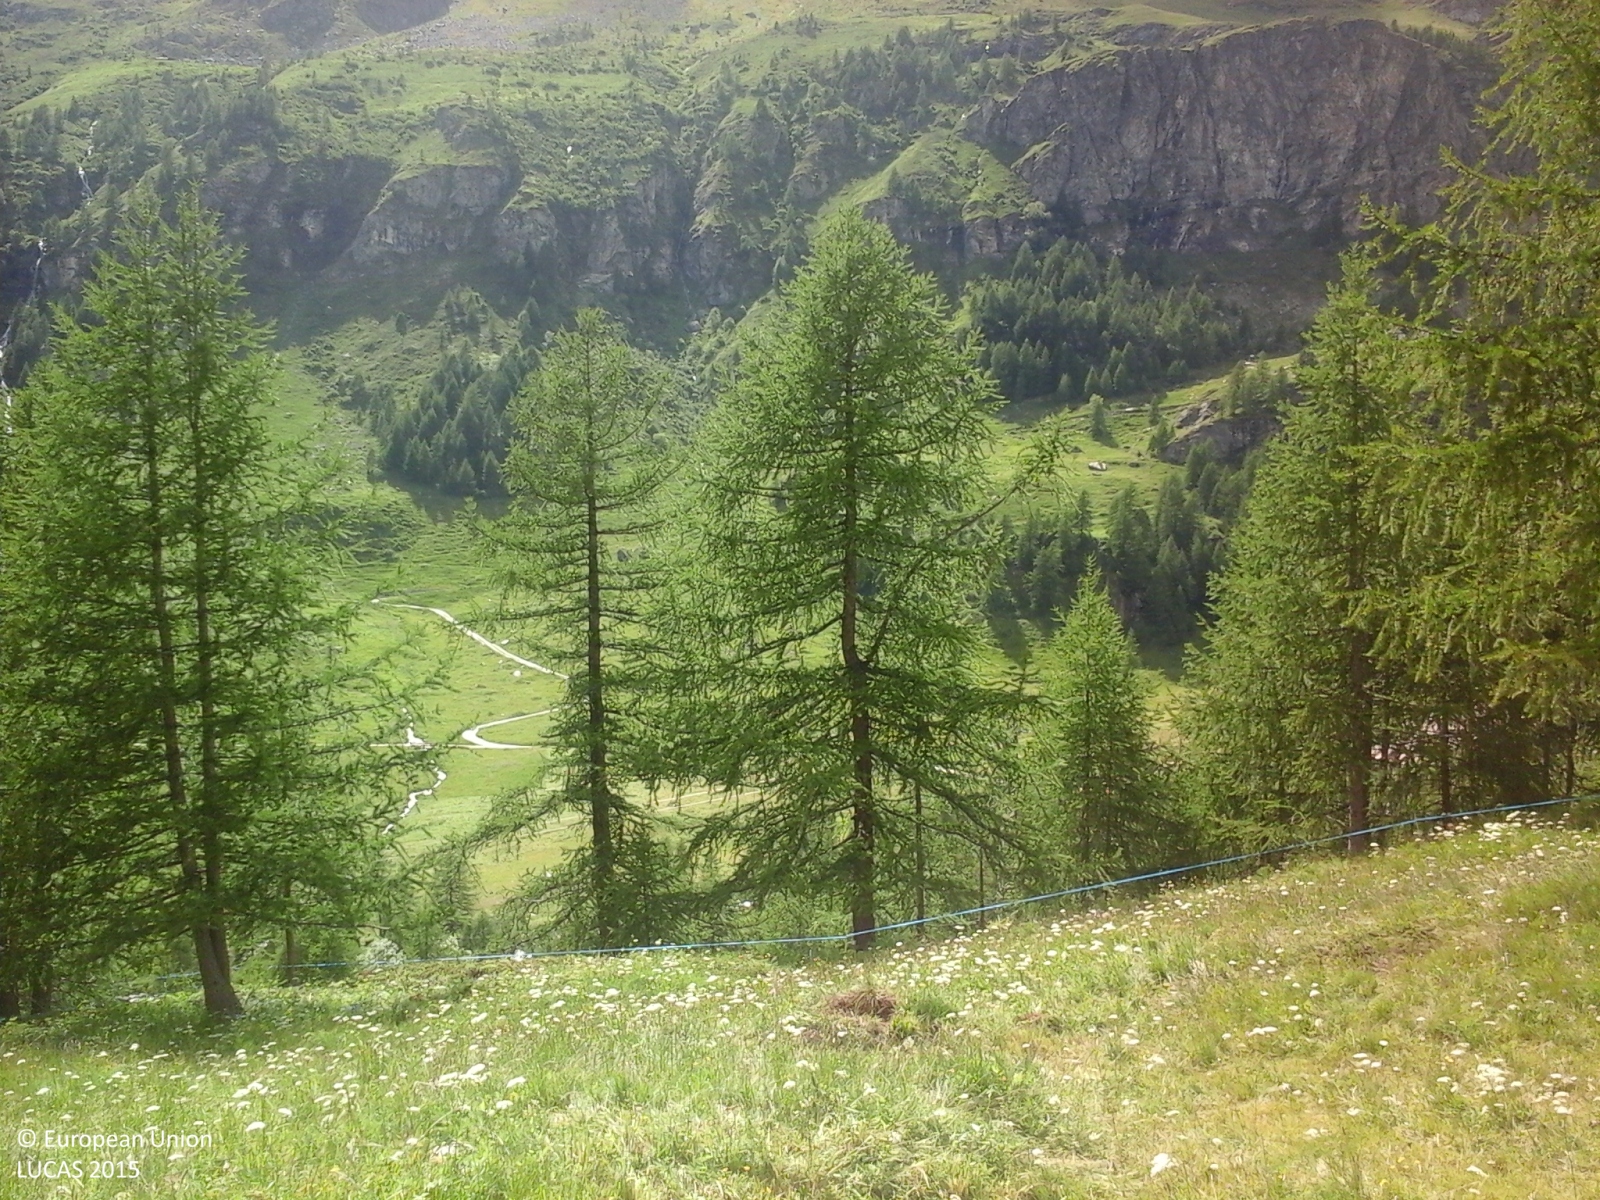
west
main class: Grassland
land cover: Grassland without tree/shrub cover
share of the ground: > 75 %
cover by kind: herbaceous plants 100 %
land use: Agriculture (excluding fallow land and kitchen gardens)
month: June
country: IT
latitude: 45.9102
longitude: 7.6183
